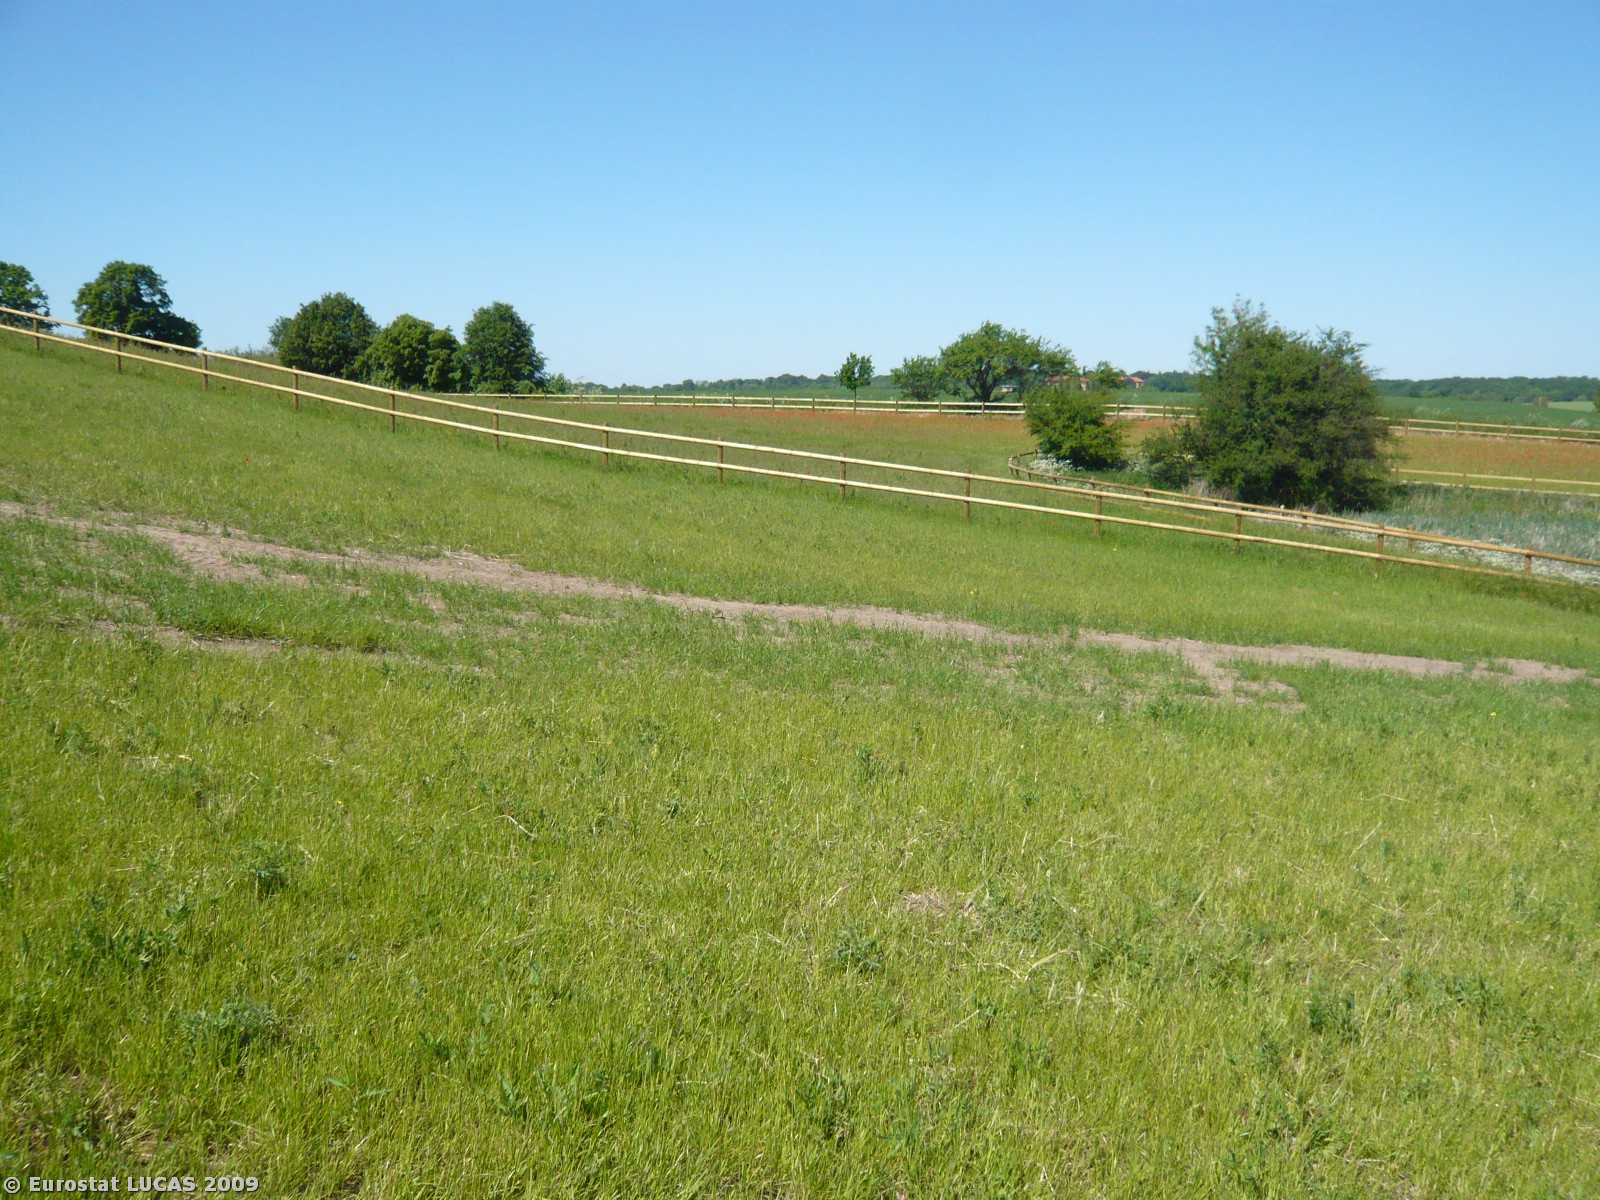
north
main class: Grassland
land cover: Grassland without tree/shrub cover
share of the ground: > 75 %
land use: Agriculture (excluding fallow land and kitchen gardens)
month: June
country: DK
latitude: 55.6505
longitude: 12.0165
